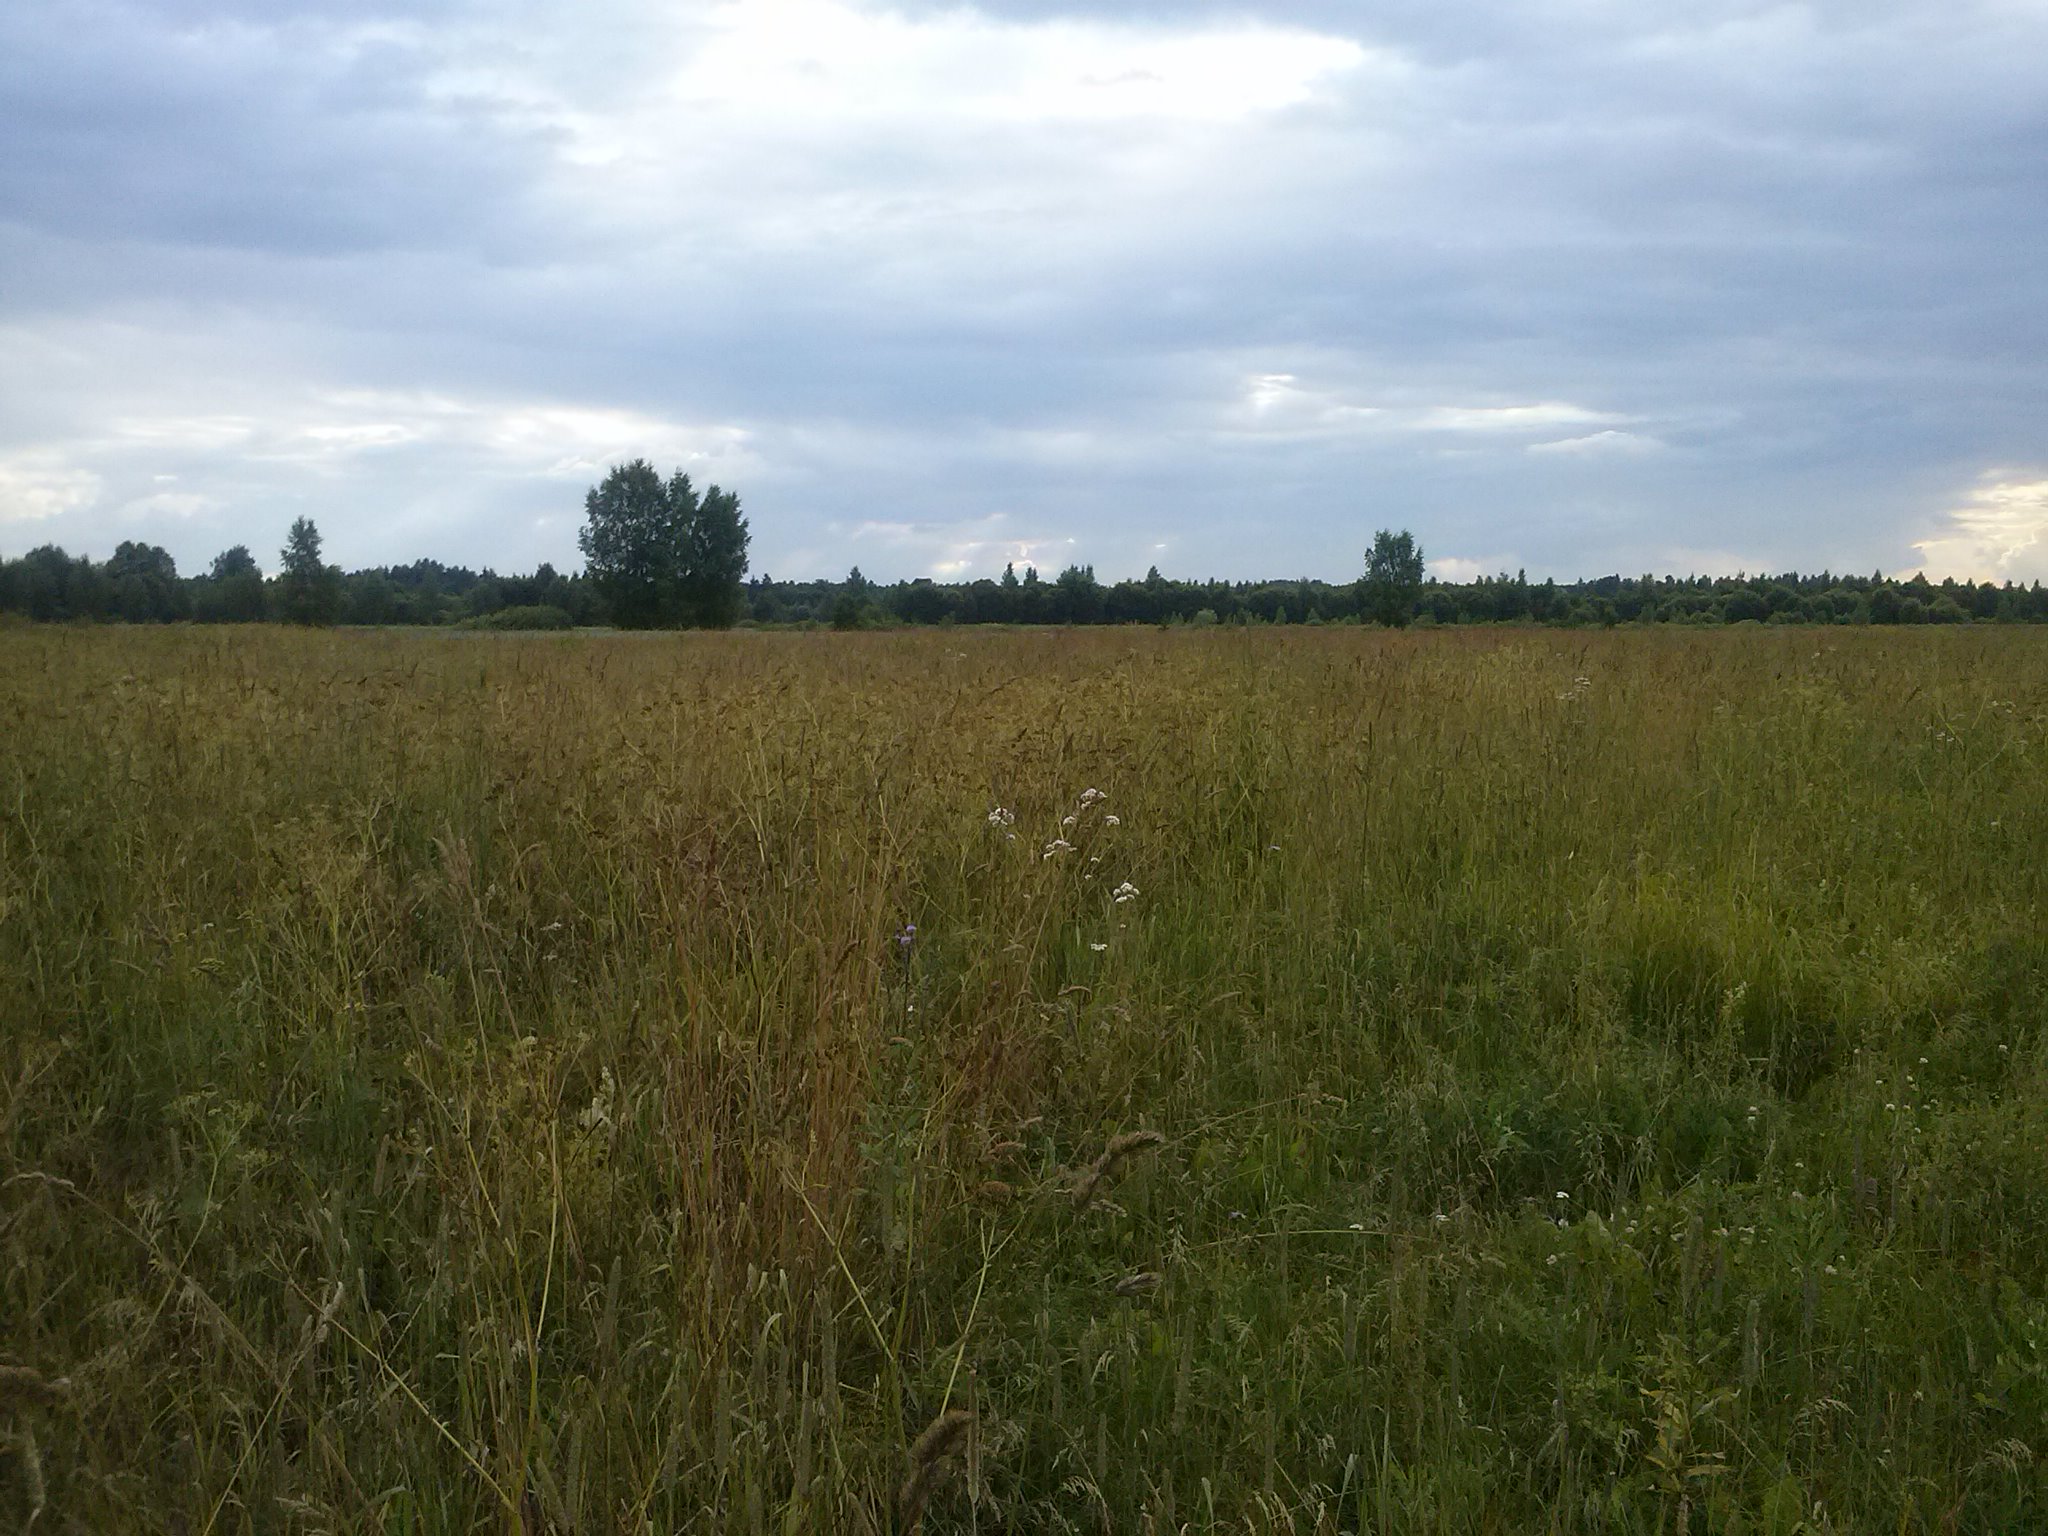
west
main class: Grassland
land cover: Grassland without tree/shrub cover
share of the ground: > 75 %
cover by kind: herbaceous plants 100 %
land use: Agriculture (excluding fallow land and kitchen gardens)
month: July
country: LV
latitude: 56.7606
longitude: 27.7718
